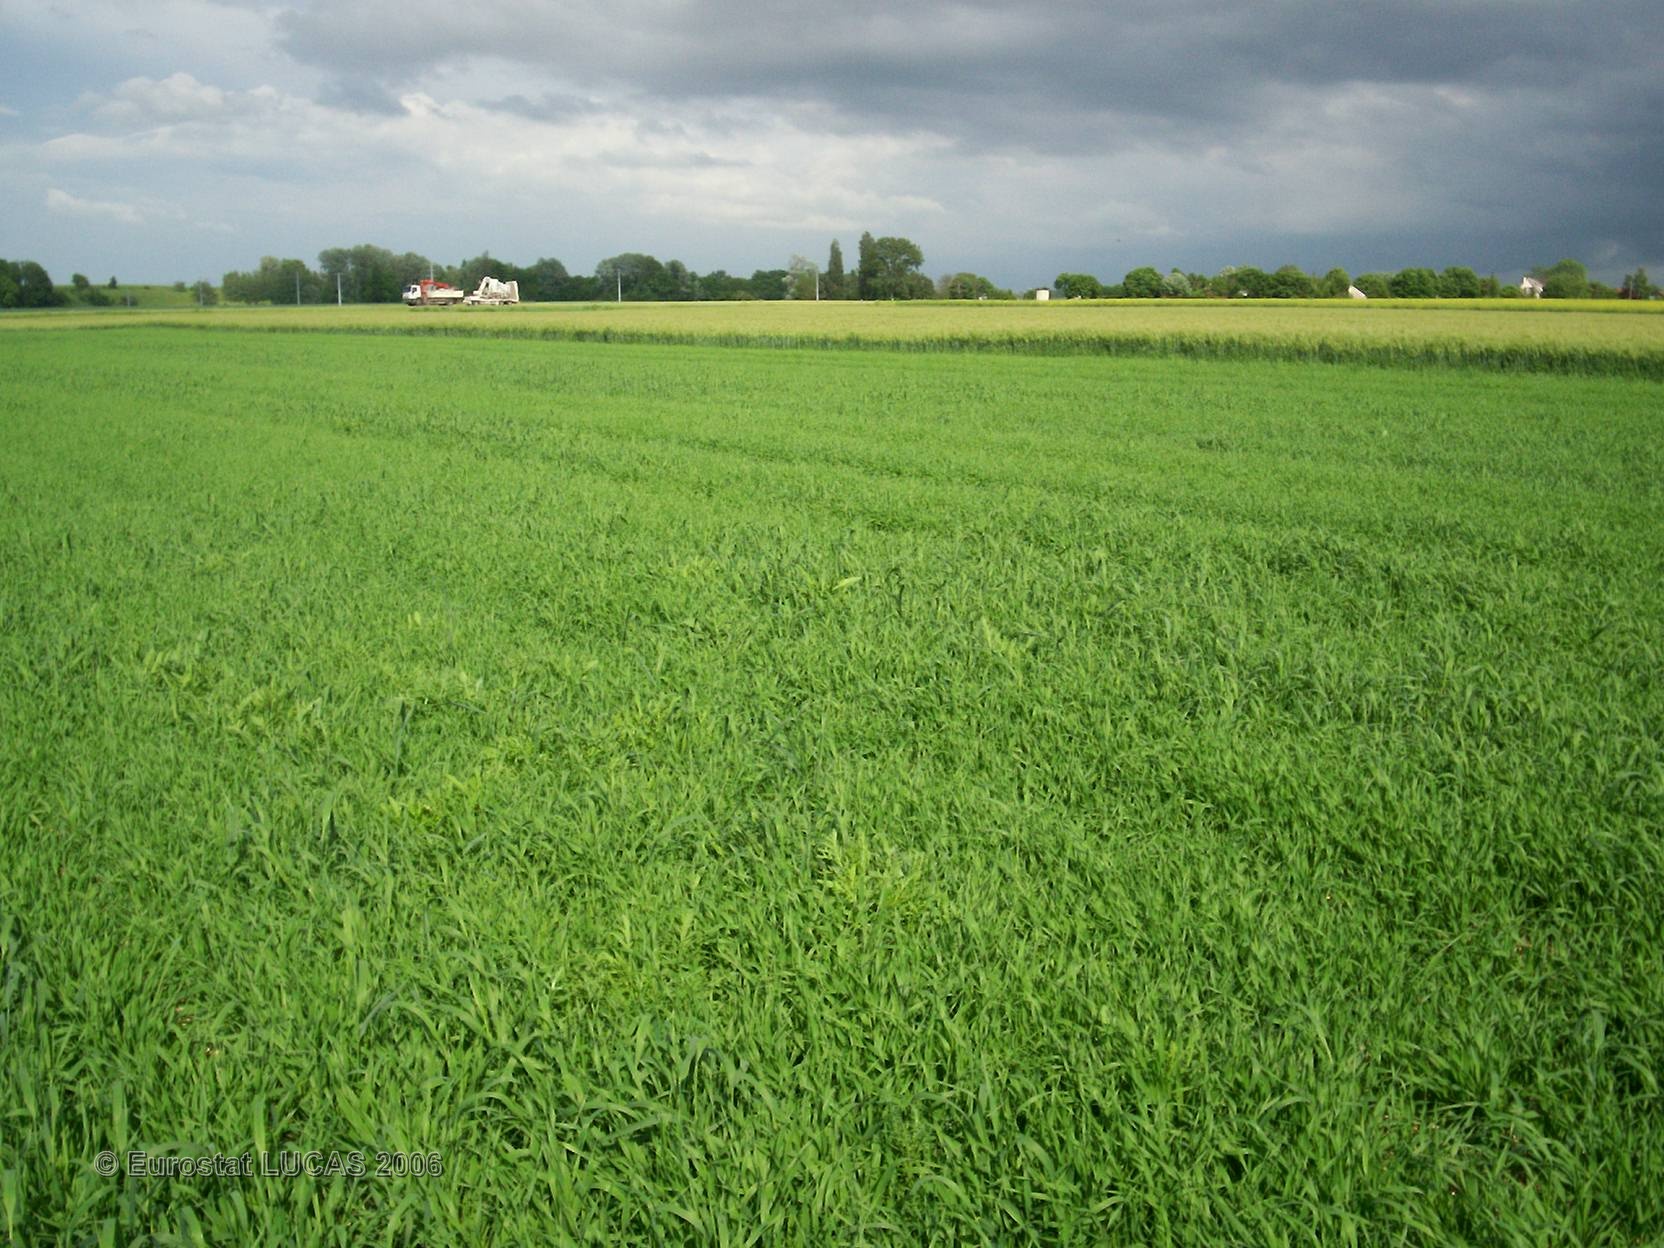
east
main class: Cropland
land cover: Barley
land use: Agriculture (excluding fallow land and kitchen gardens)
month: May
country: FR
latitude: 48.4109
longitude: 4.4988
